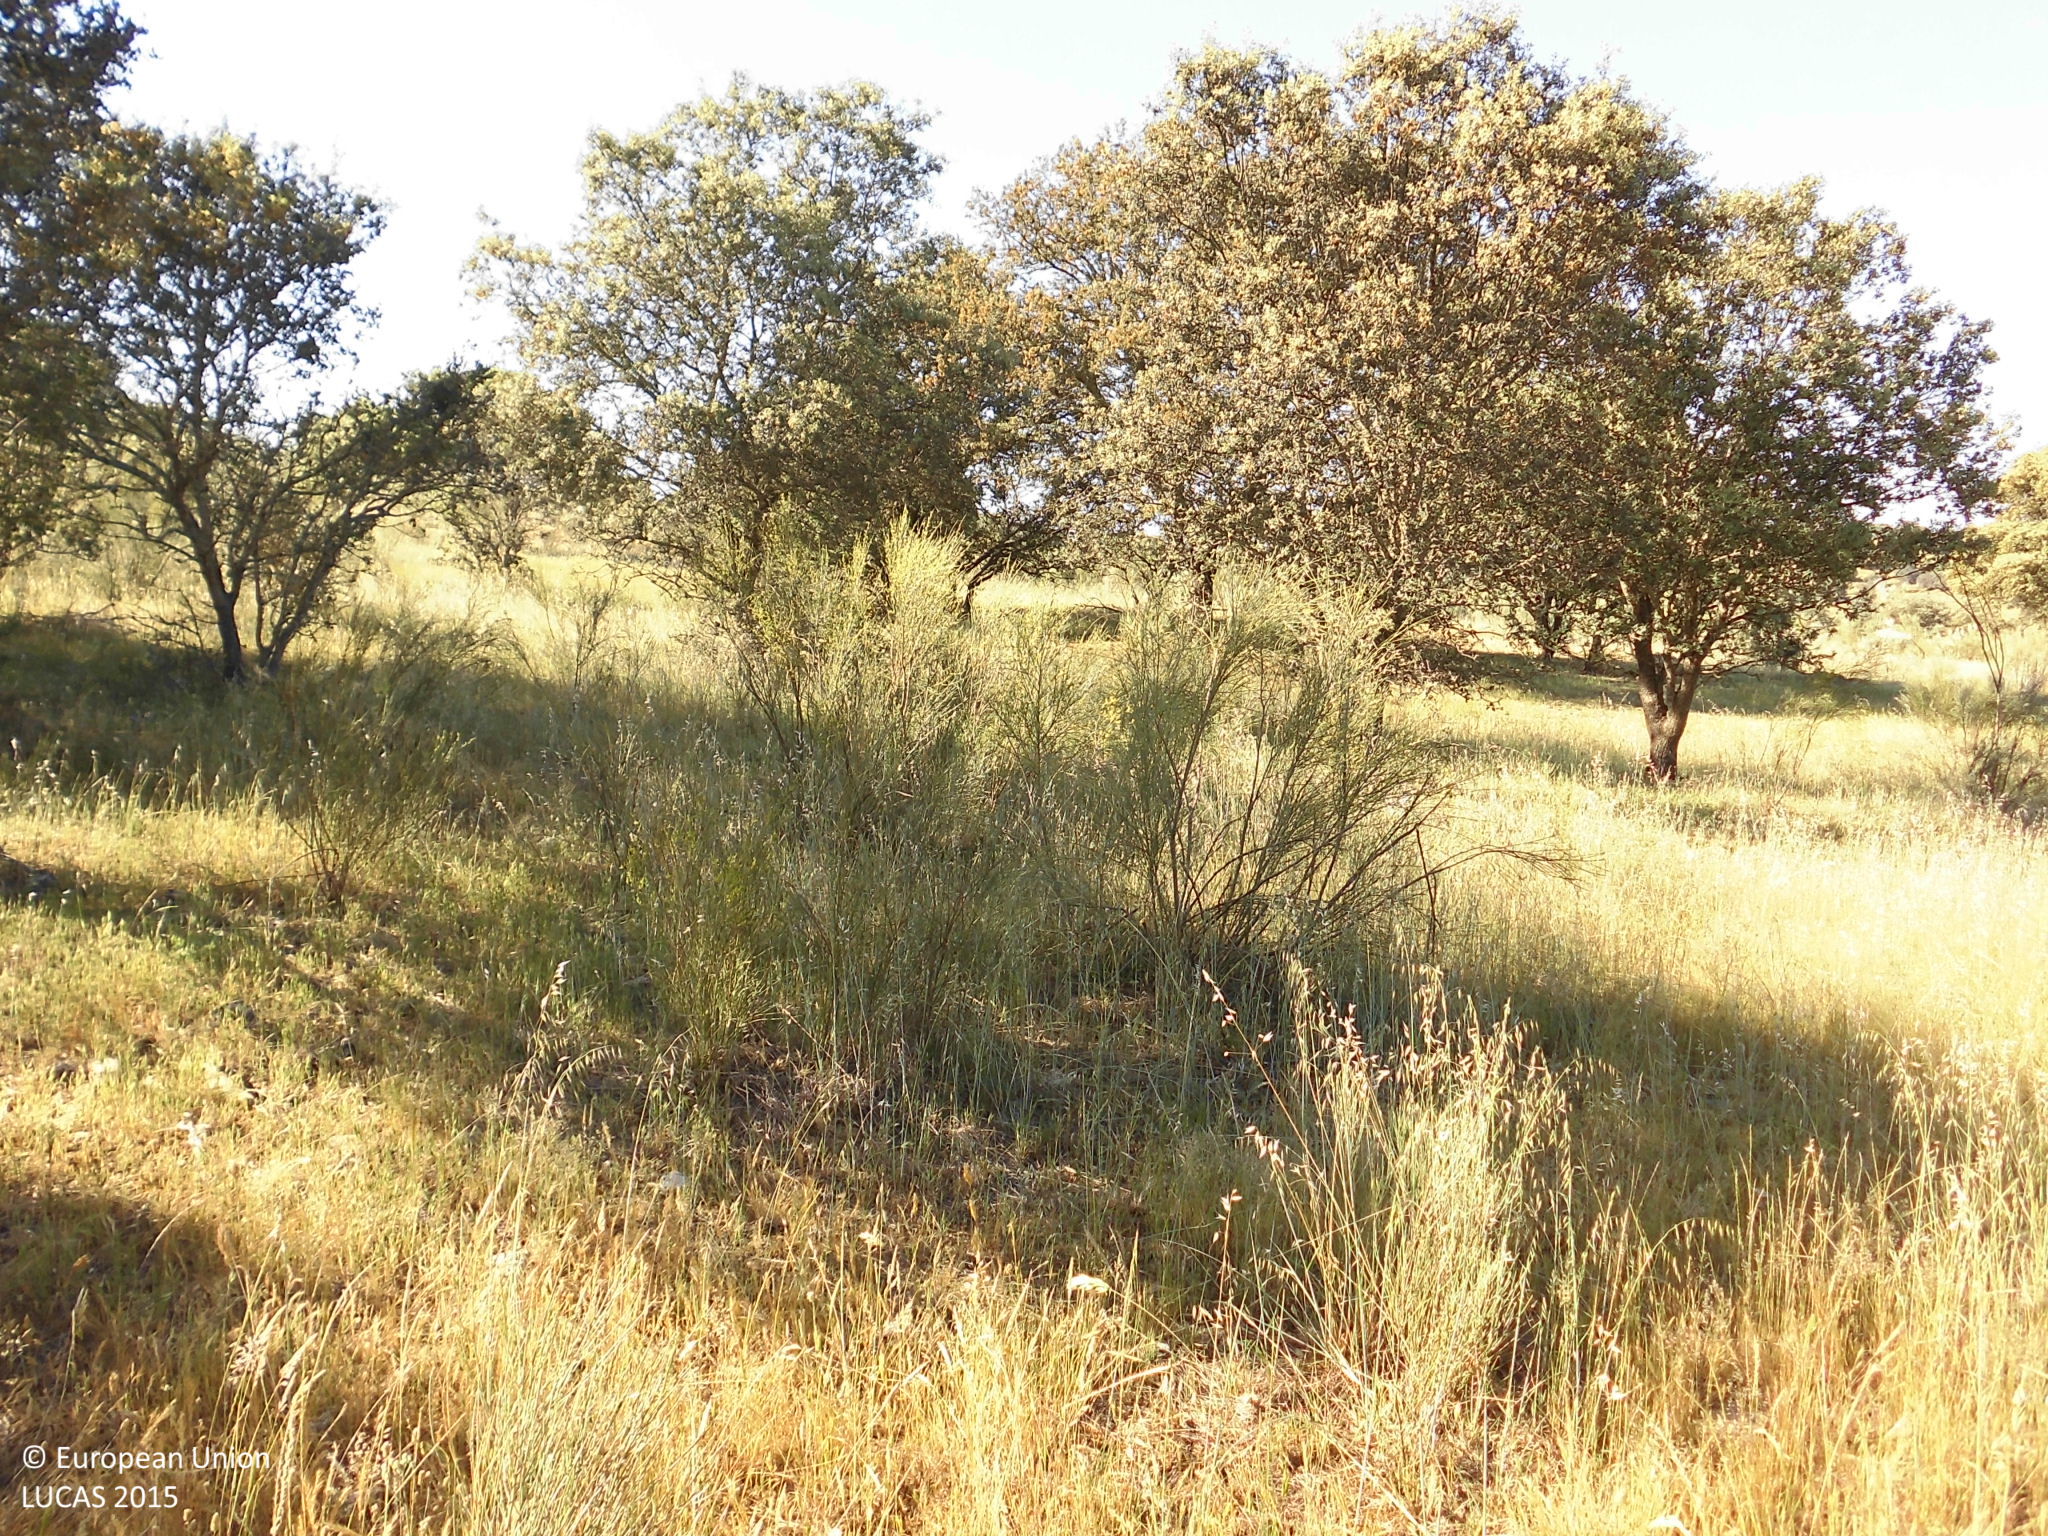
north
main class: Woodland
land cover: Broadleaved woodland
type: broadleaved evergreen forest
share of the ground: 25 - 50 %
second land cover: Grassland without tree/shrub cover
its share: > 75 %
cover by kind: herbaceous plants 55 %, broadleaved forest trees 40 %, shrubs 5 %
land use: Forestry
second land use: Agriculture (excluding fallow land and kitchen gardens)
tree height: > 5 m
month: May
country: ES
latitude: 39.5201
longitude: -6.0806
